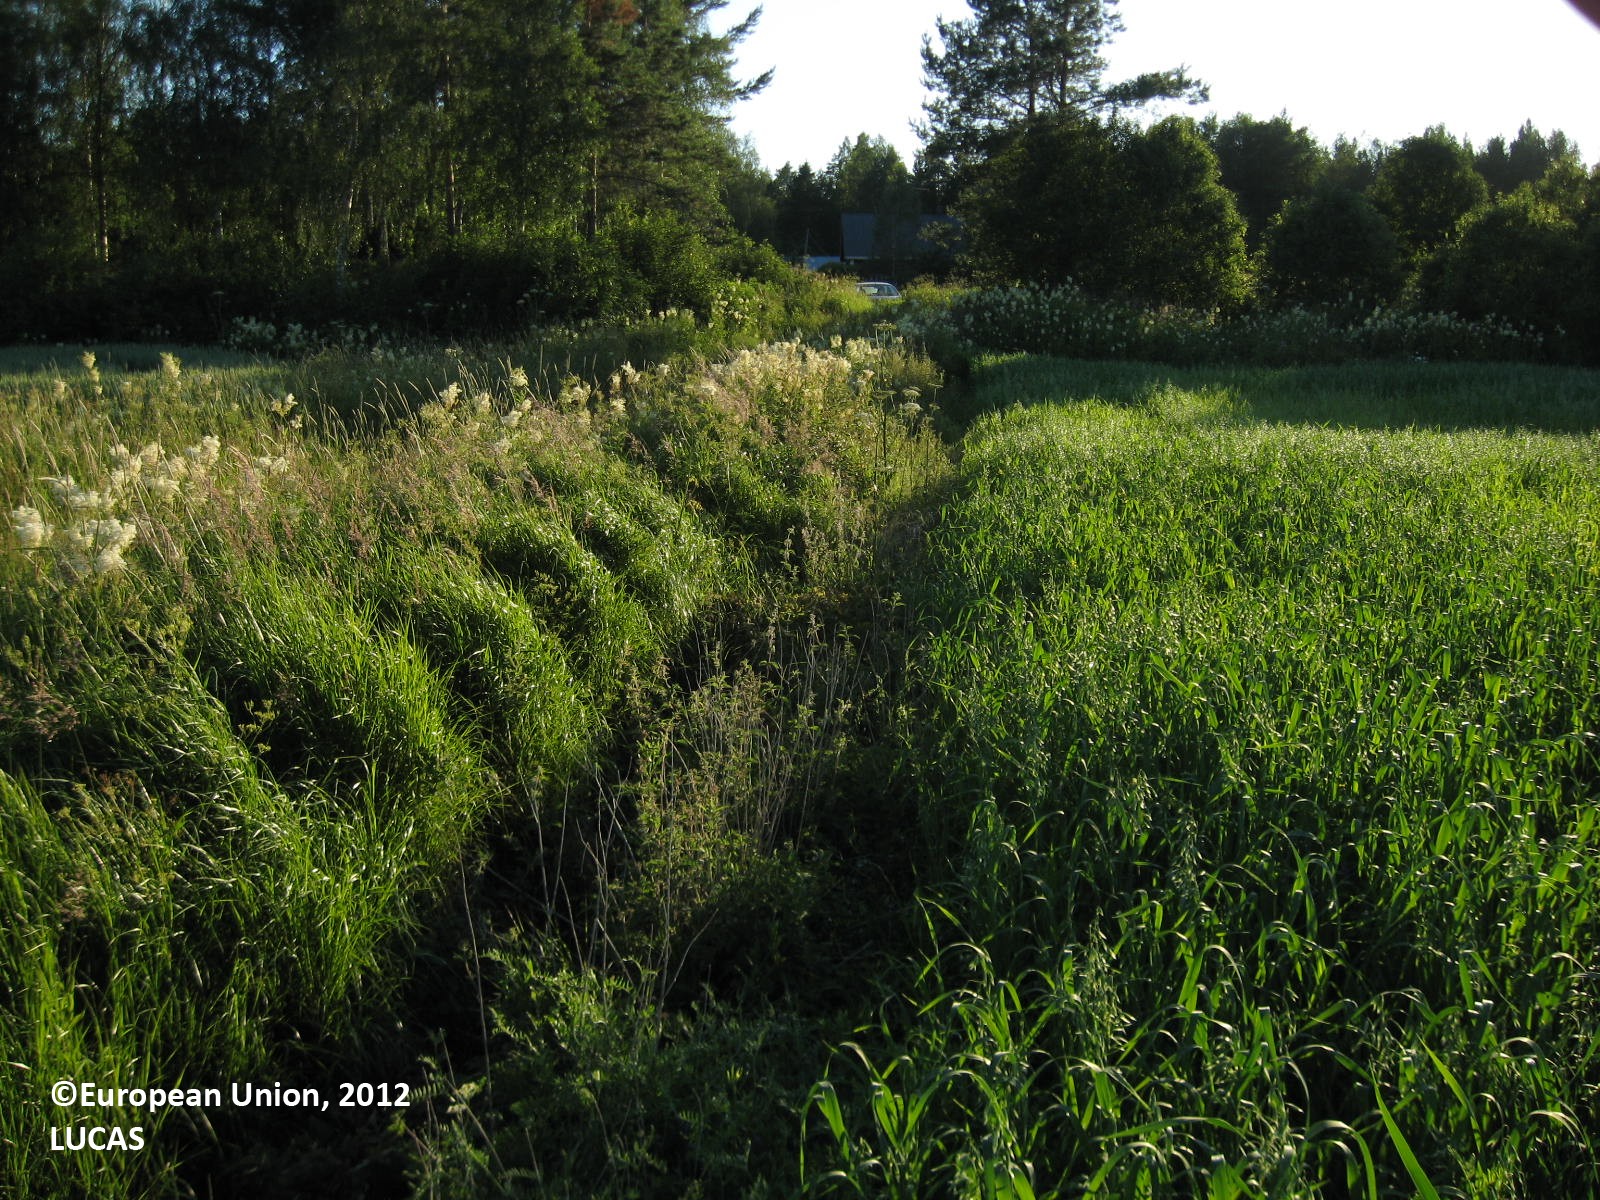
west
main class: Cropland
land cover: Oats
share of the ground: > 75 %
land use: Agriculture (excluding fallow land and kitchen gardens)
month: July
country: FI
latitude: 62.1460
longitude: 21.5774
